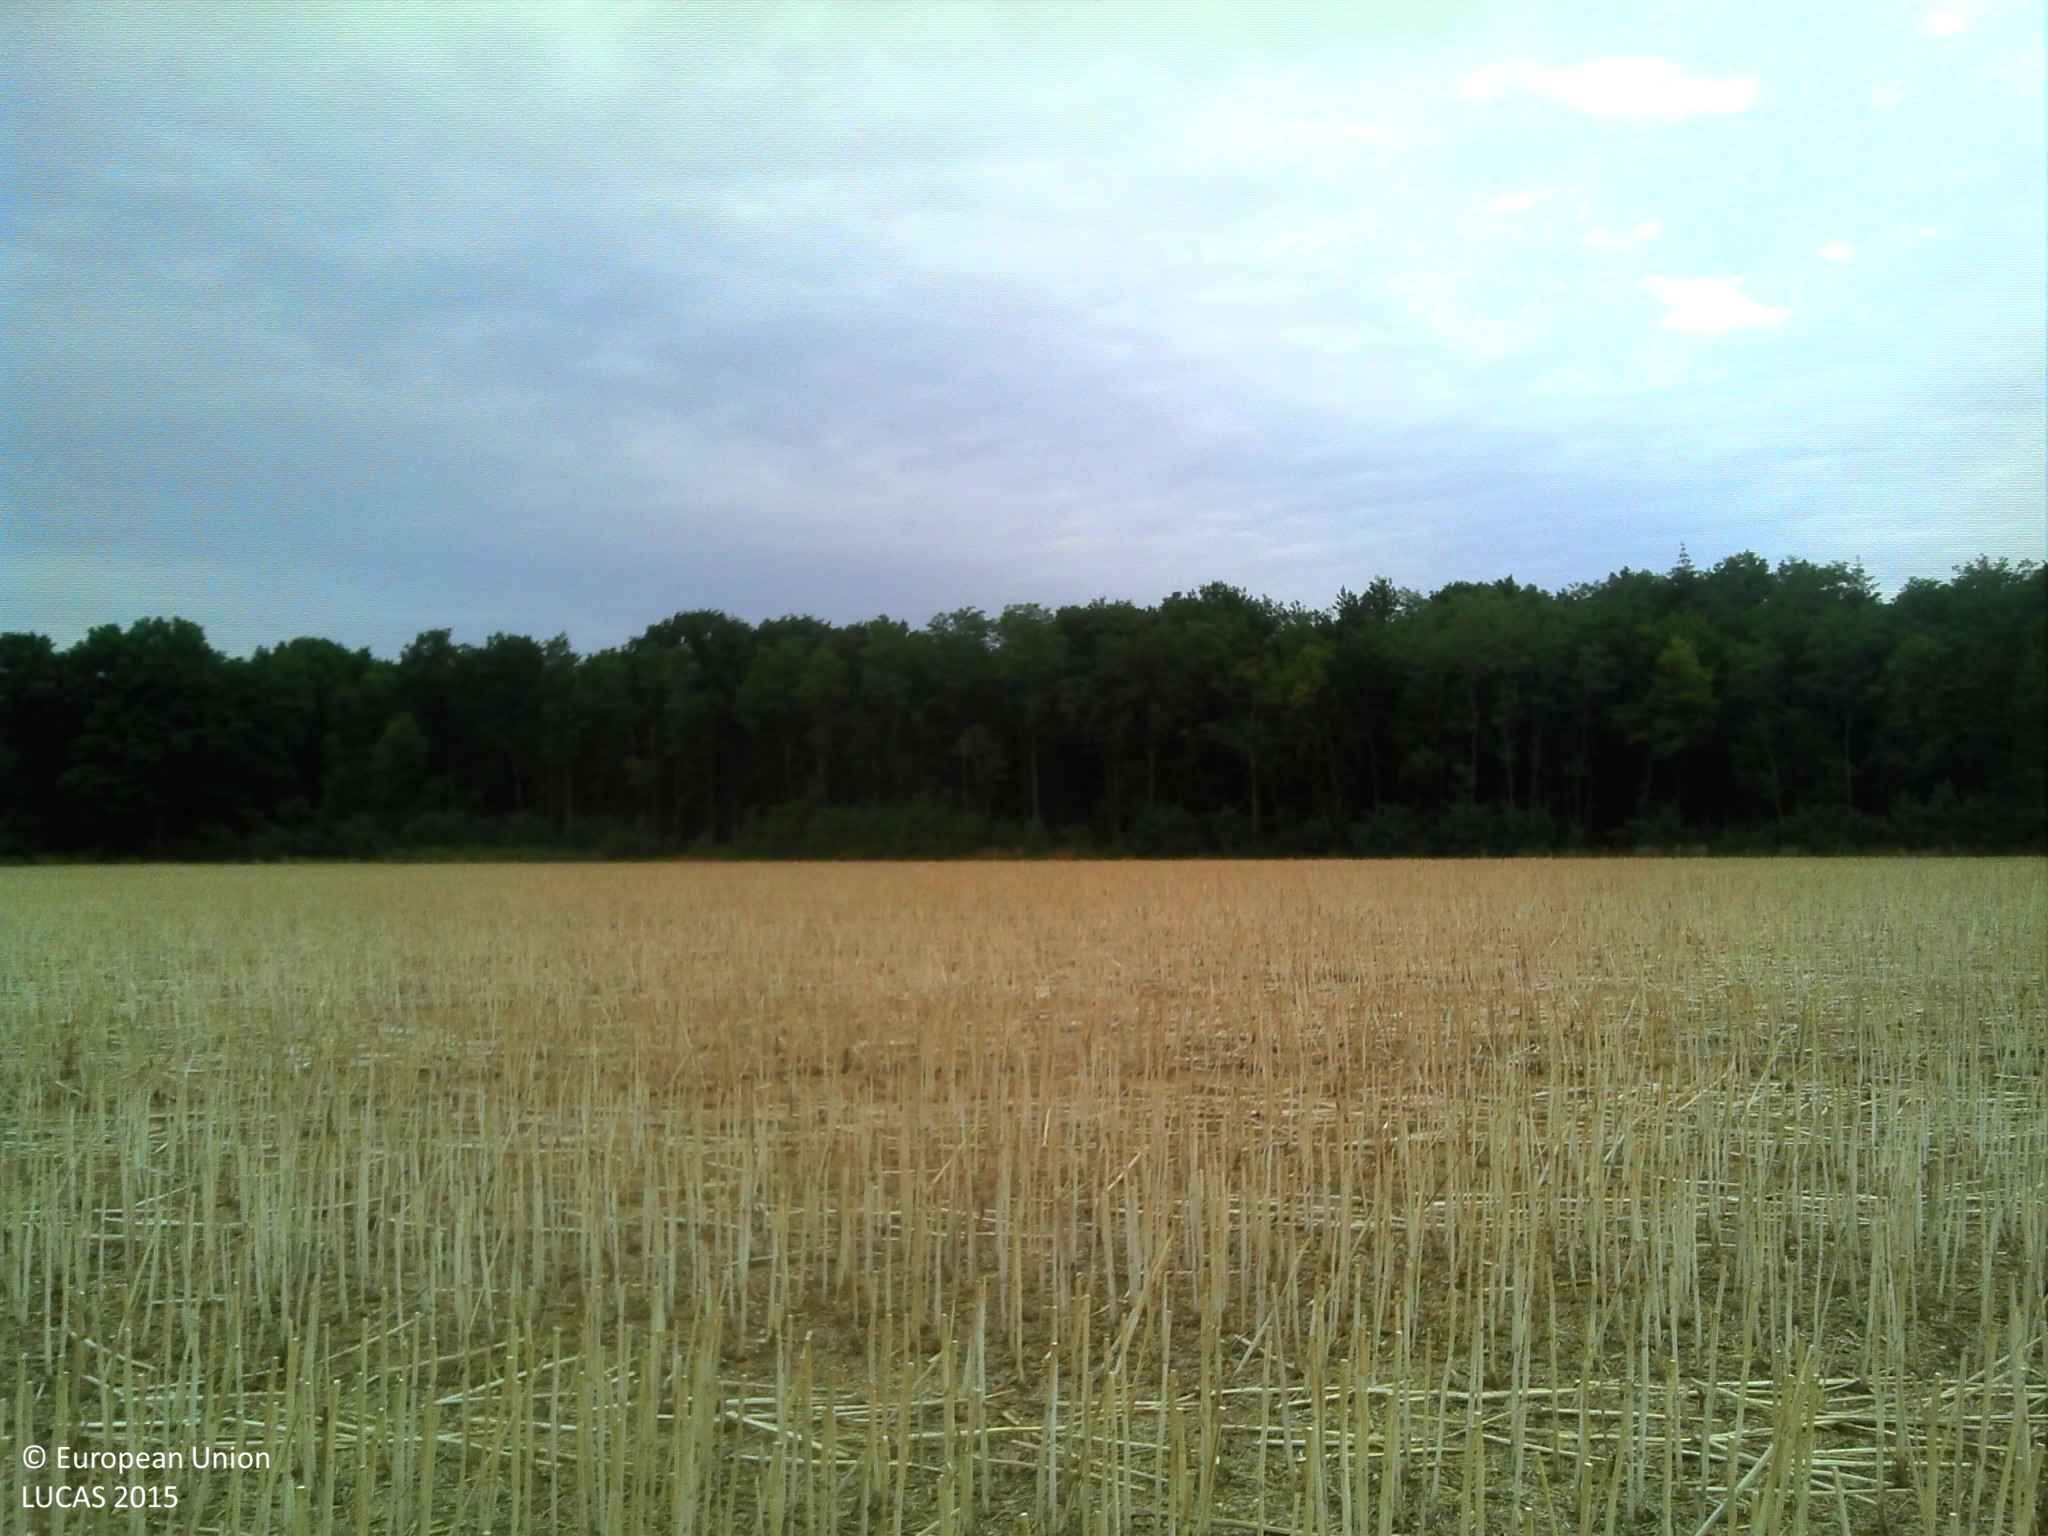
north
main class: Cropland
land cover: Rape and turnip rape
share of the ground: < 10 %
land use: Agriculture (excluding fallow land and kitchen gardens)
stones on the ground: < 10 %
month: July
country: FR
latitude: 46.8778
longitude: 4.8707
